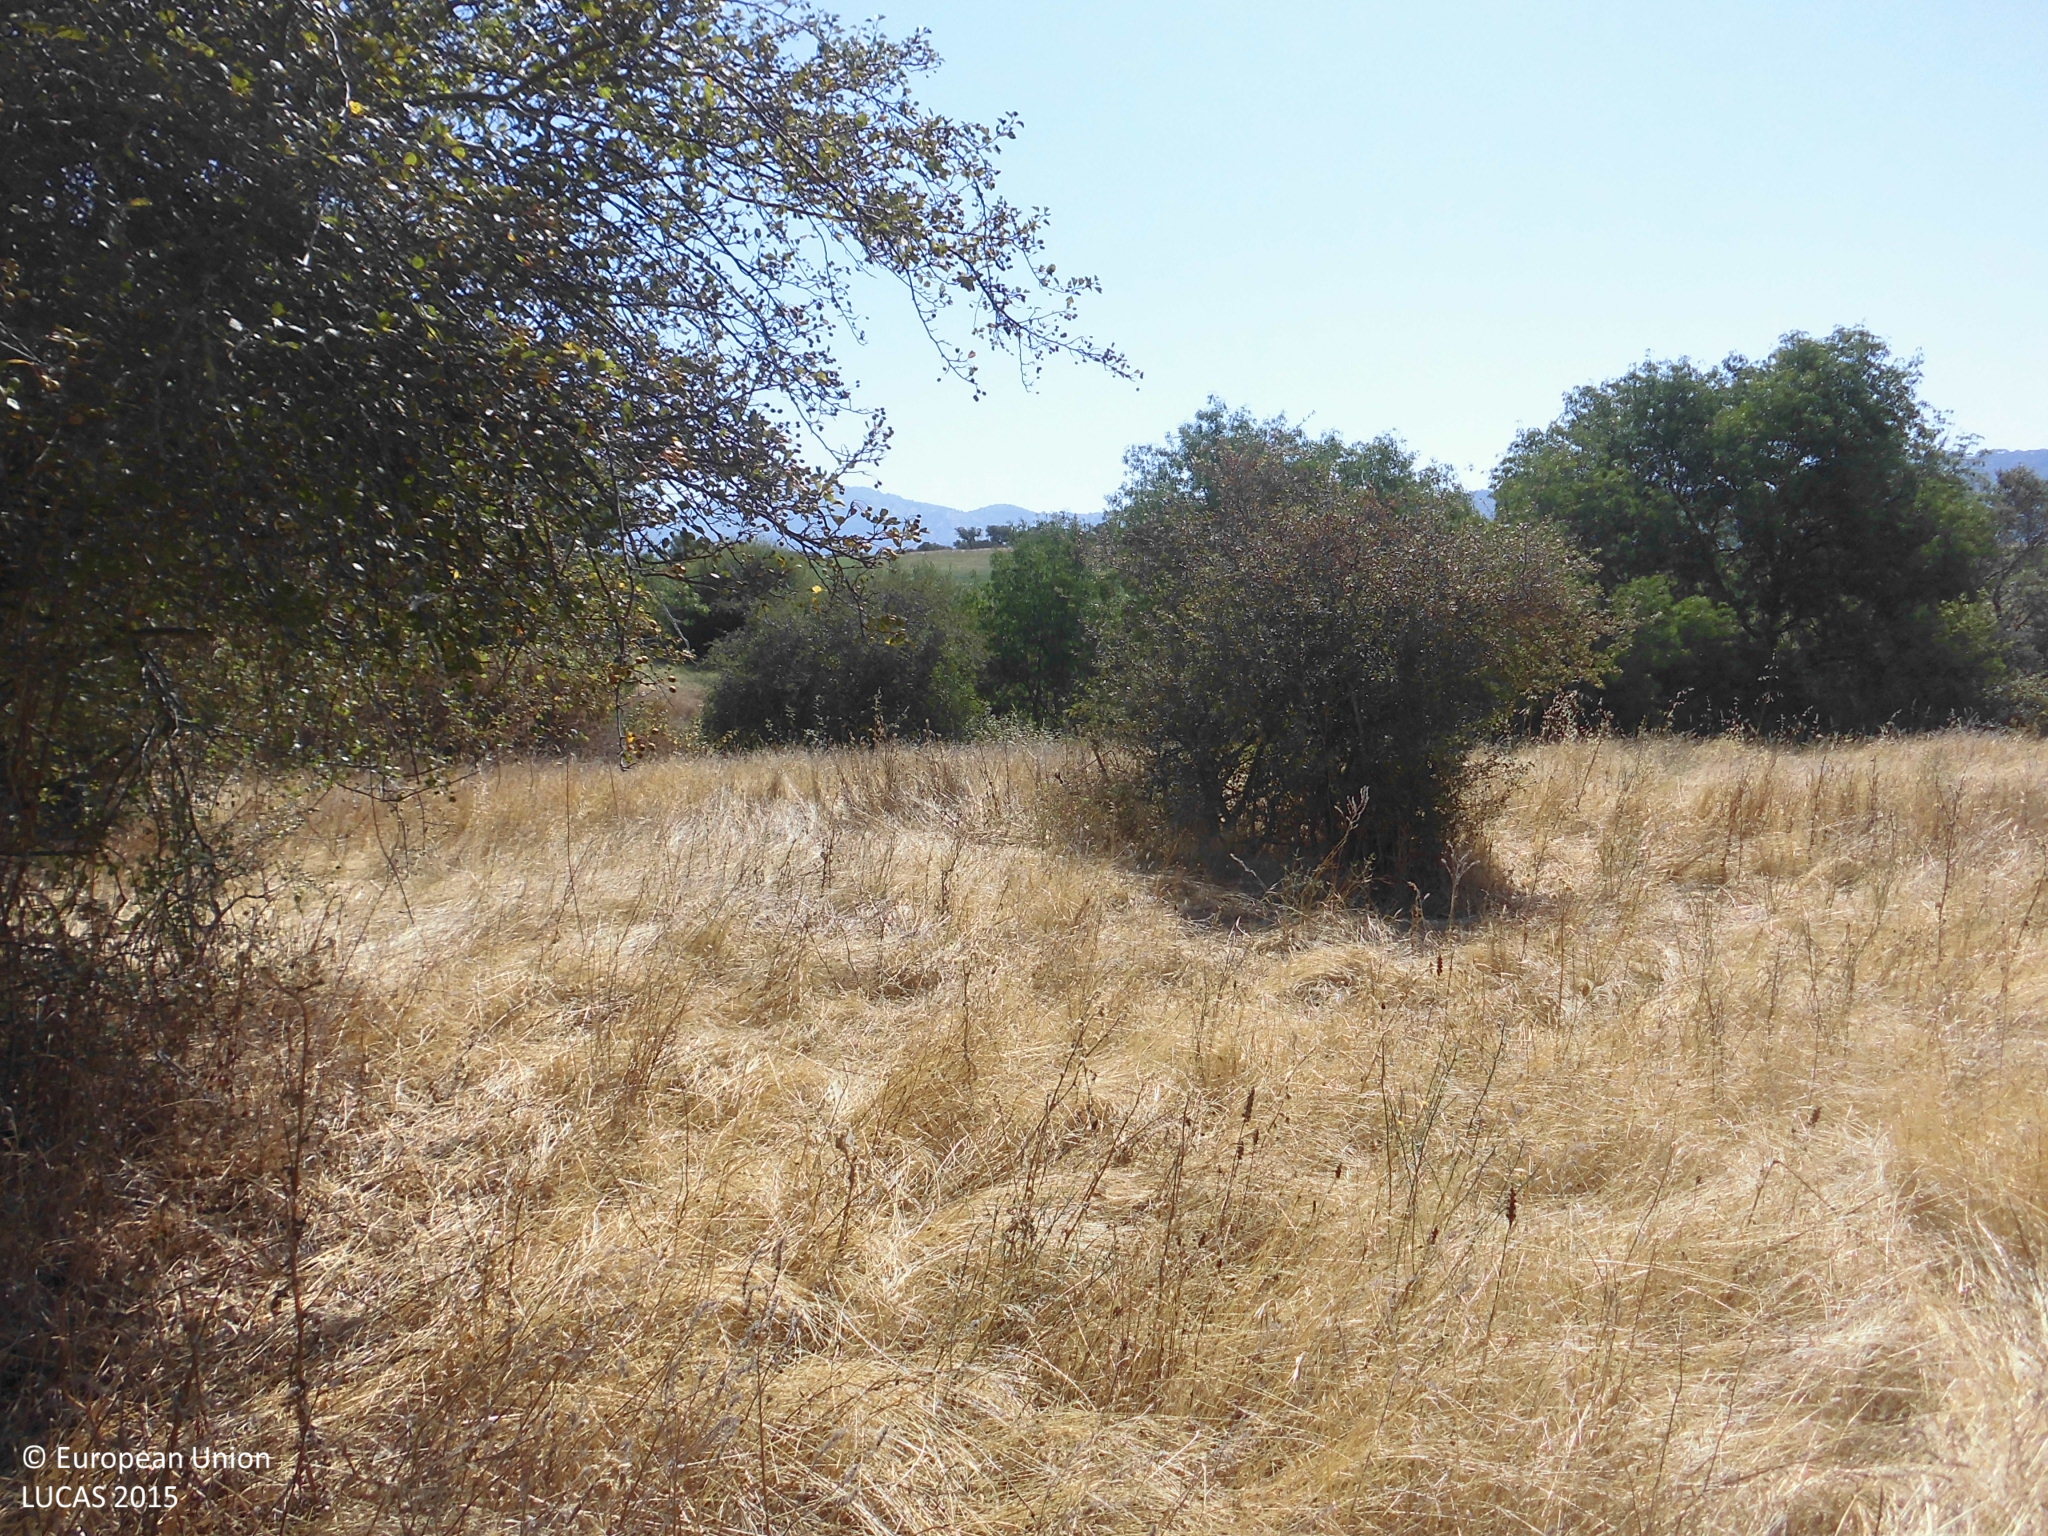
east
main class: Shrubland
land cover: Shrubland with sparse tree cover
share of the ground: > 75 %
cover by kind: herbaceous plants 65 %, shrubs 30 %, broadleaved forest trees 5 %
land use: Semi-natural and natural areas not in use
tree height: > 5 m
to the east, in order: Shrubland with sparse tree cover; Abandoned hedges; Rivers and streams; Grassland with sparse tree/shrub cover; Temporary grasslands
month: July
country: ES
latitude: 40.0826
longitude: -6.1279
